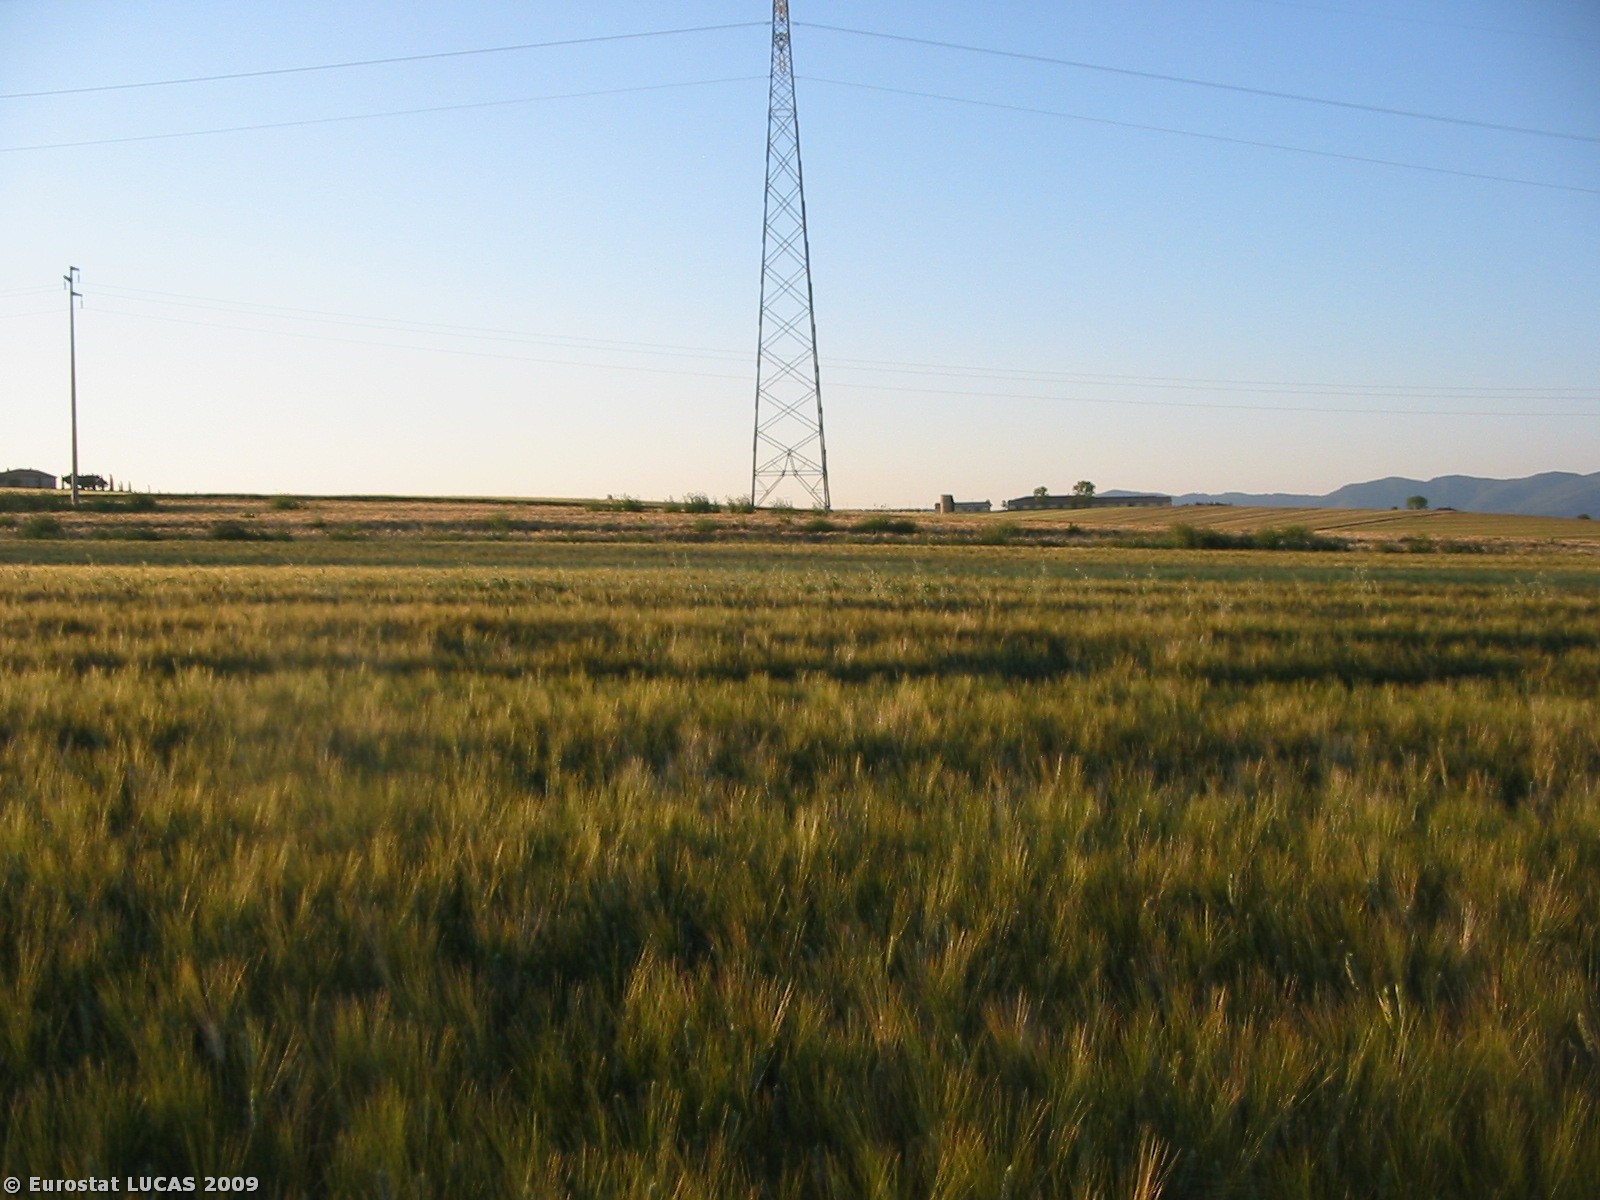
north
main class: Cropland
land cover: Durum wheat
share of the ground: > 75 %
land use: Agriculture (excluding fallow land and kitchen gardens)
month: June
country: IT
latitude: 43.2692
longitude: 11.8551
